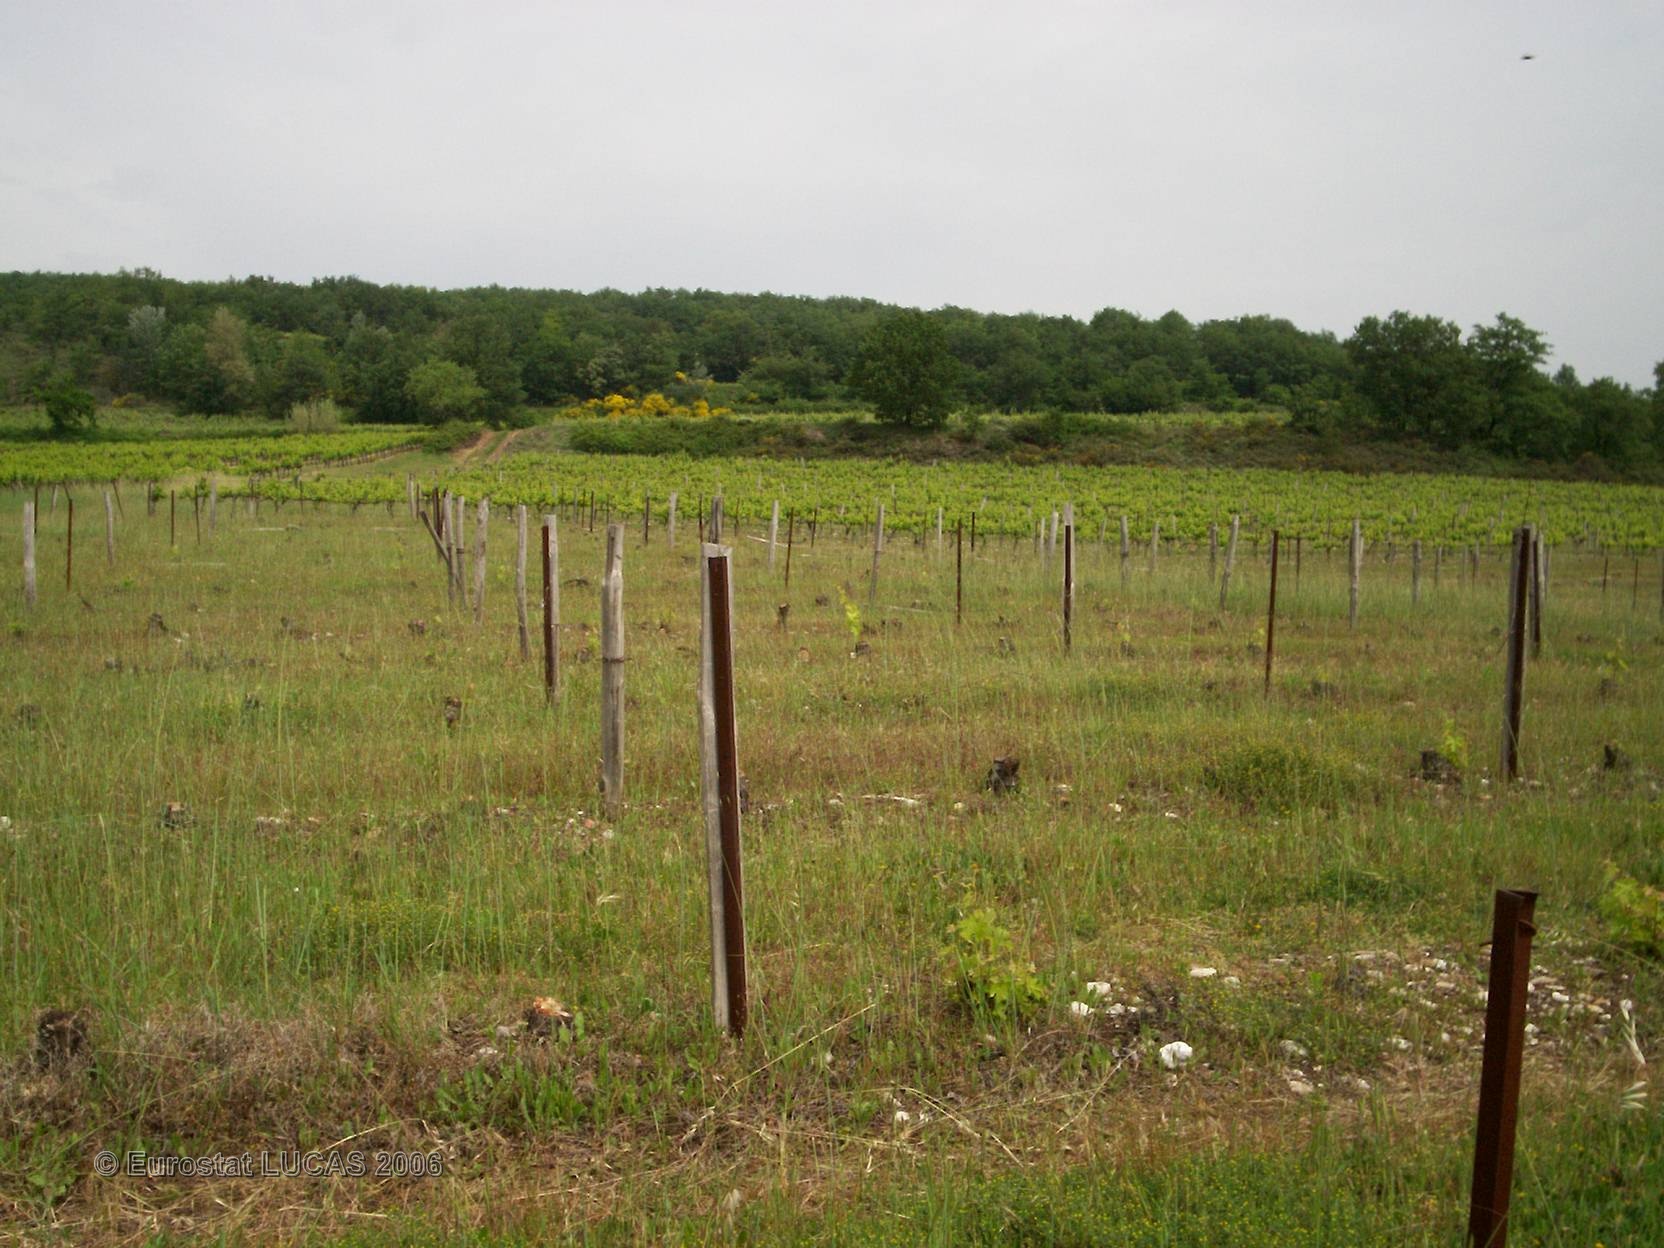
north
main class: Cropland
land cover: Vineyards
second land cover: Grassland with sparse tree/shrub cover
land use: Agriculture (excluding fallow land and kitchen gardens)
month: May
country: FR
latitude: 44.4212
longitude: 4.8450
